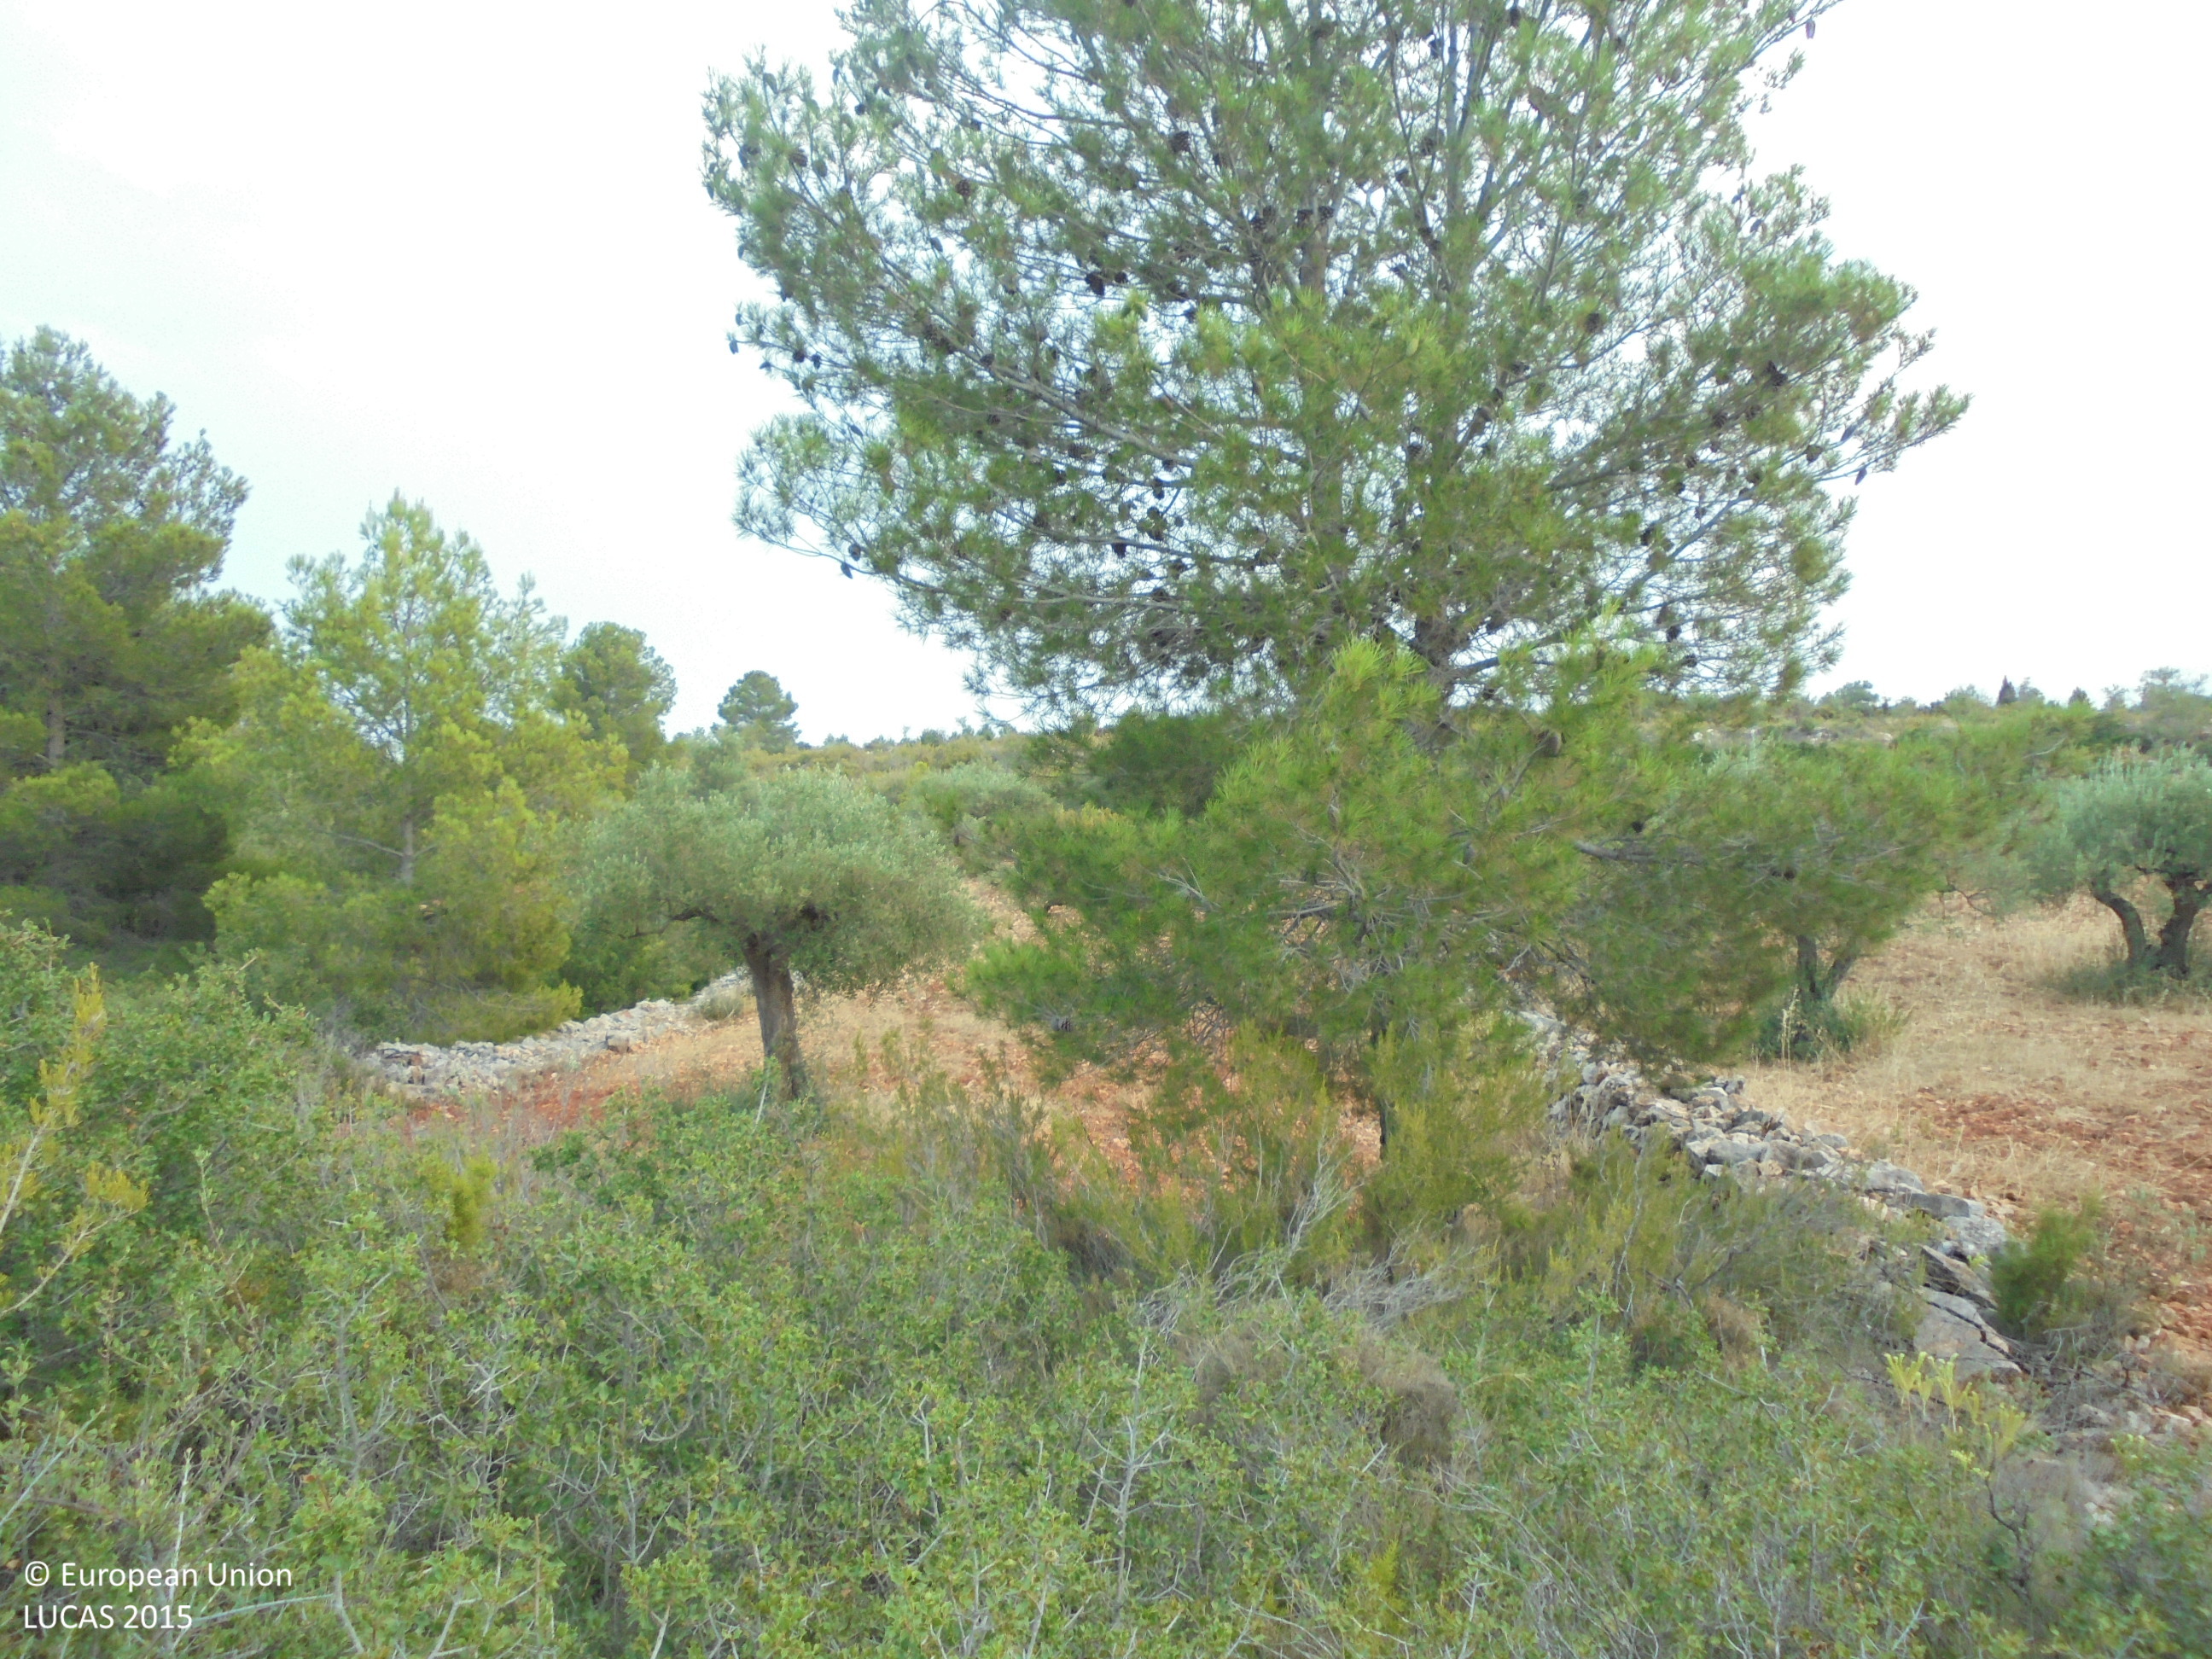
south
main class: Shrubland
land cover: Shrubland with sparse tree cover
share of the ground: > 75 %
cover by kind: shrubs 90 %, coniferous forest trees 5 %, unconsolidated bare surface 5 %
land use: Semi-natural and natural areas not in use
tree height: > 5 m
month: July
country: ES
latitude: 39.2155
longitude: -0.7792
